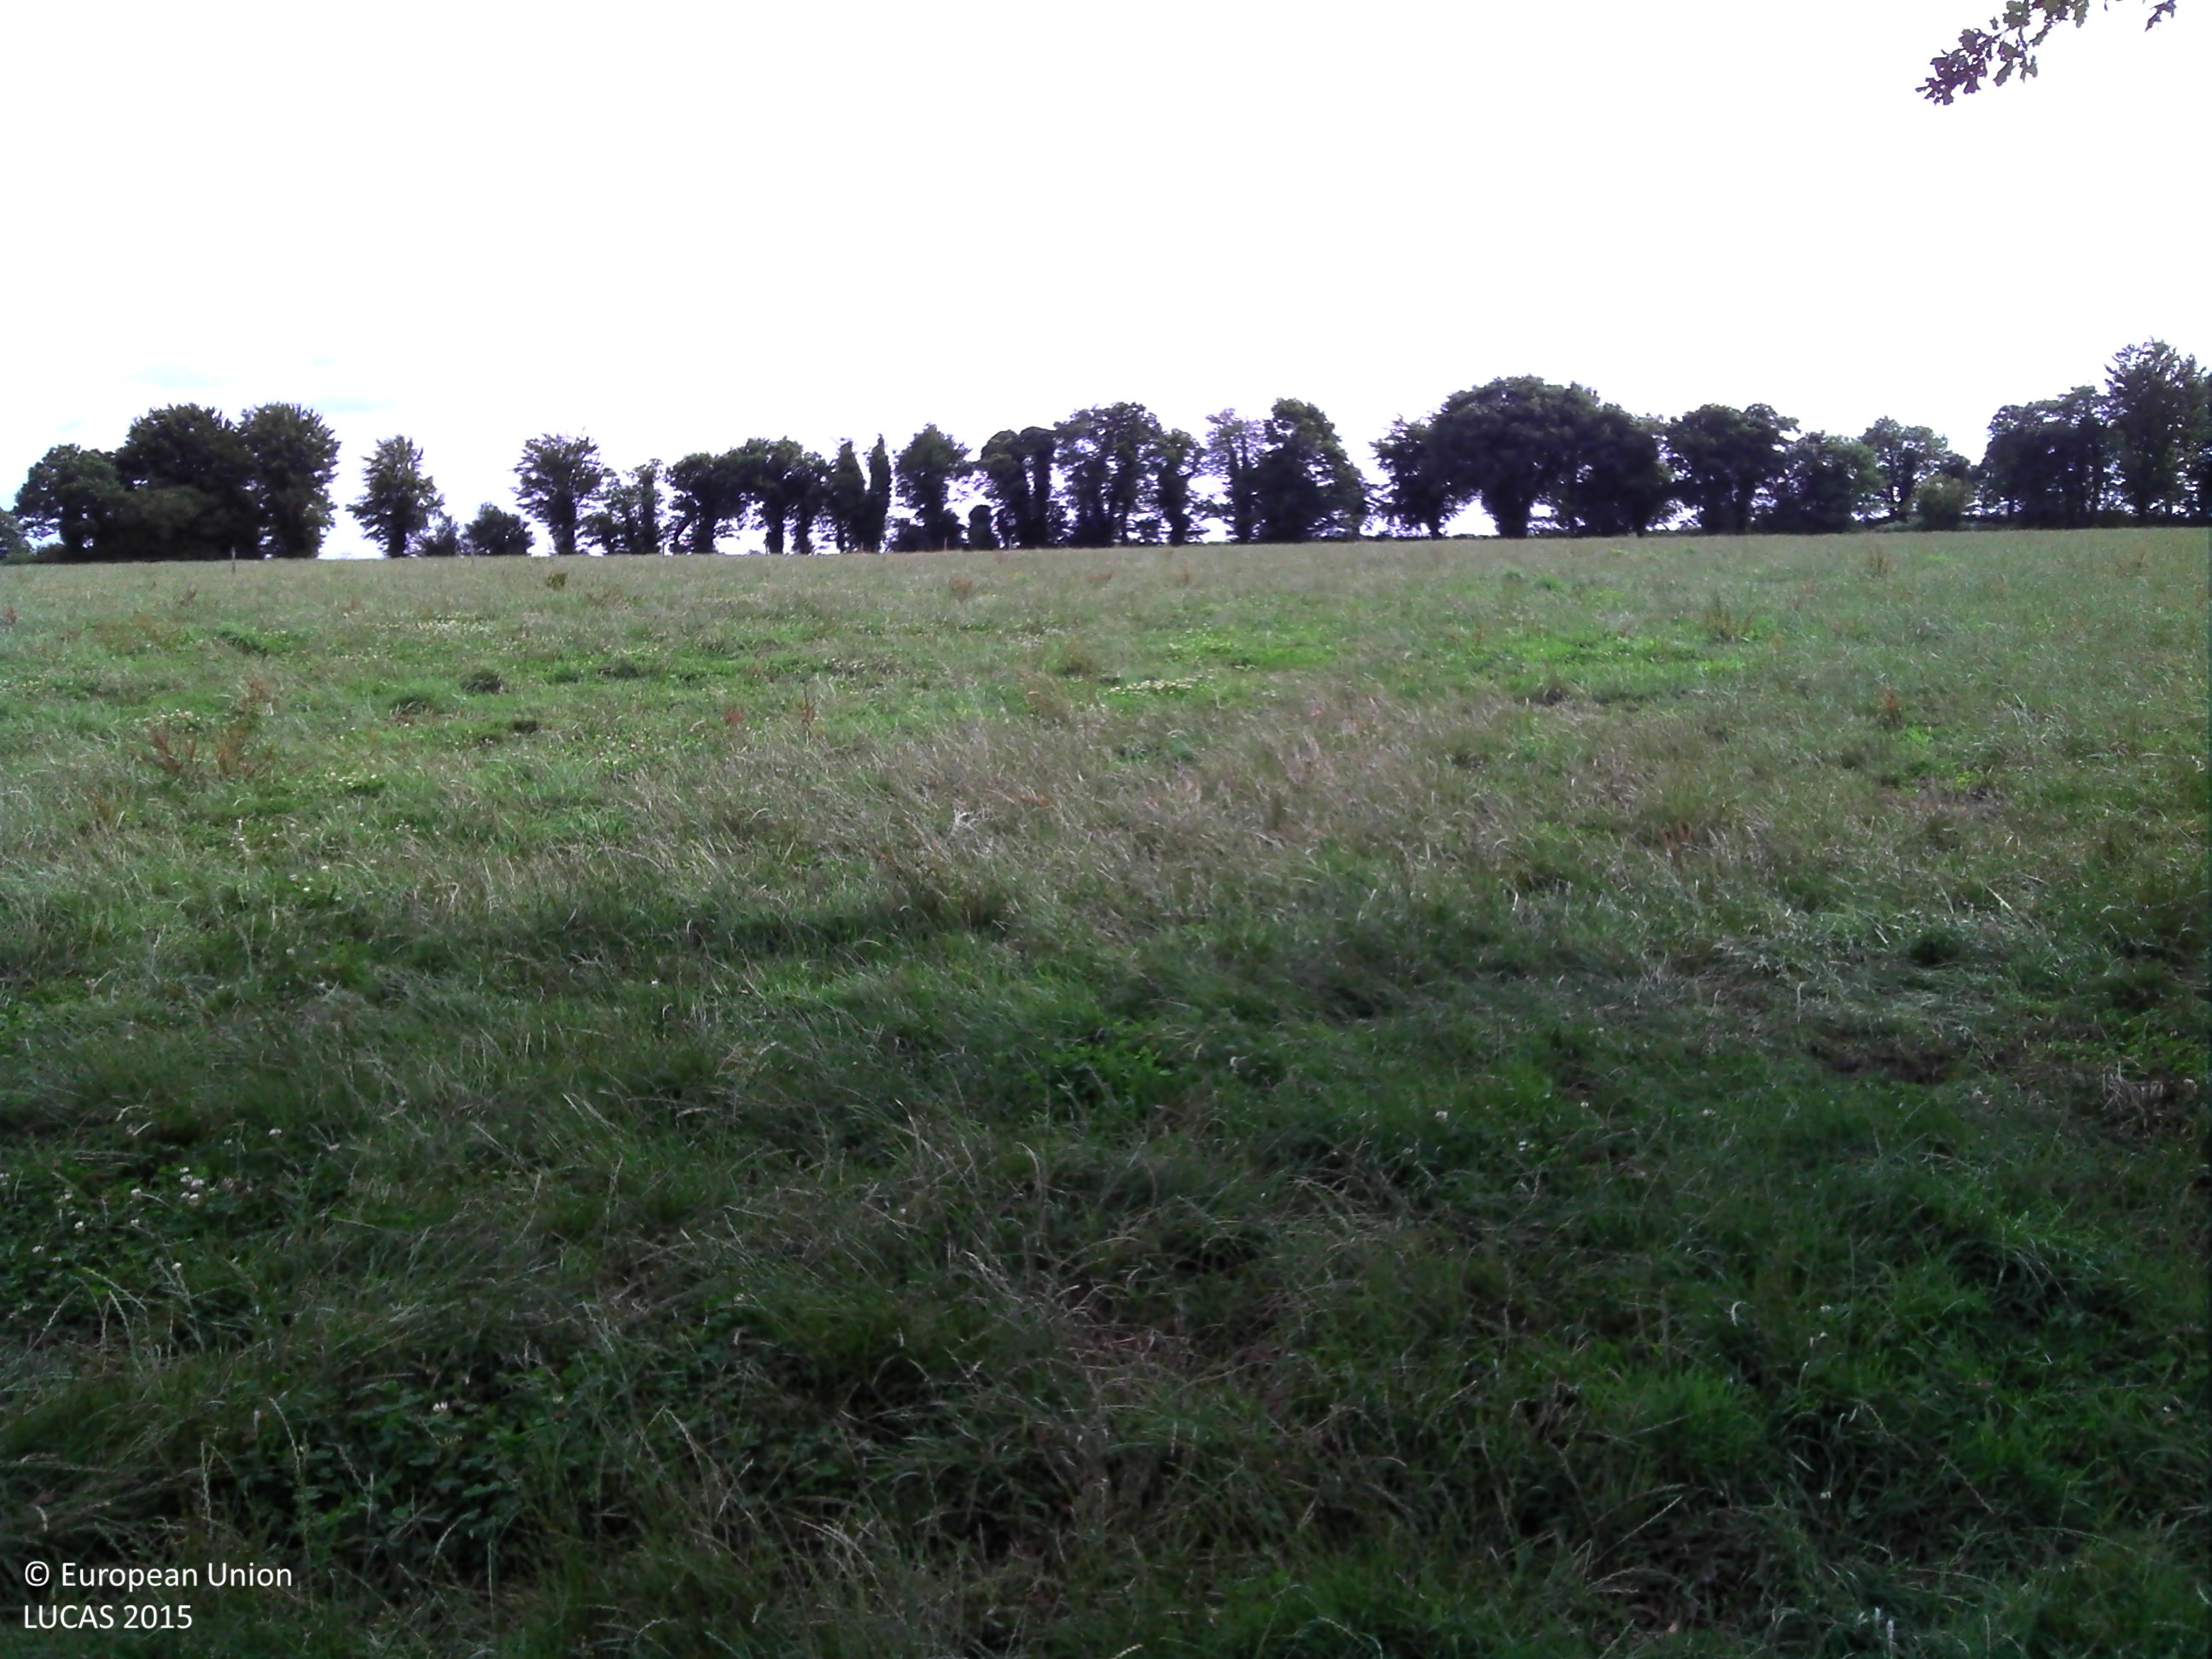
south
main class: Grassland
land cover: Grassland without tree/shrub cover
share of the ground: > 75 %
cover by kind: herbaceous plants 70 %, consolidated bare surface 30 %
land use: Agriculture (excluding fallow land and kitchen gardens)
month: July
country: FR
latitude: 47.9112
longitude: -2.9511
